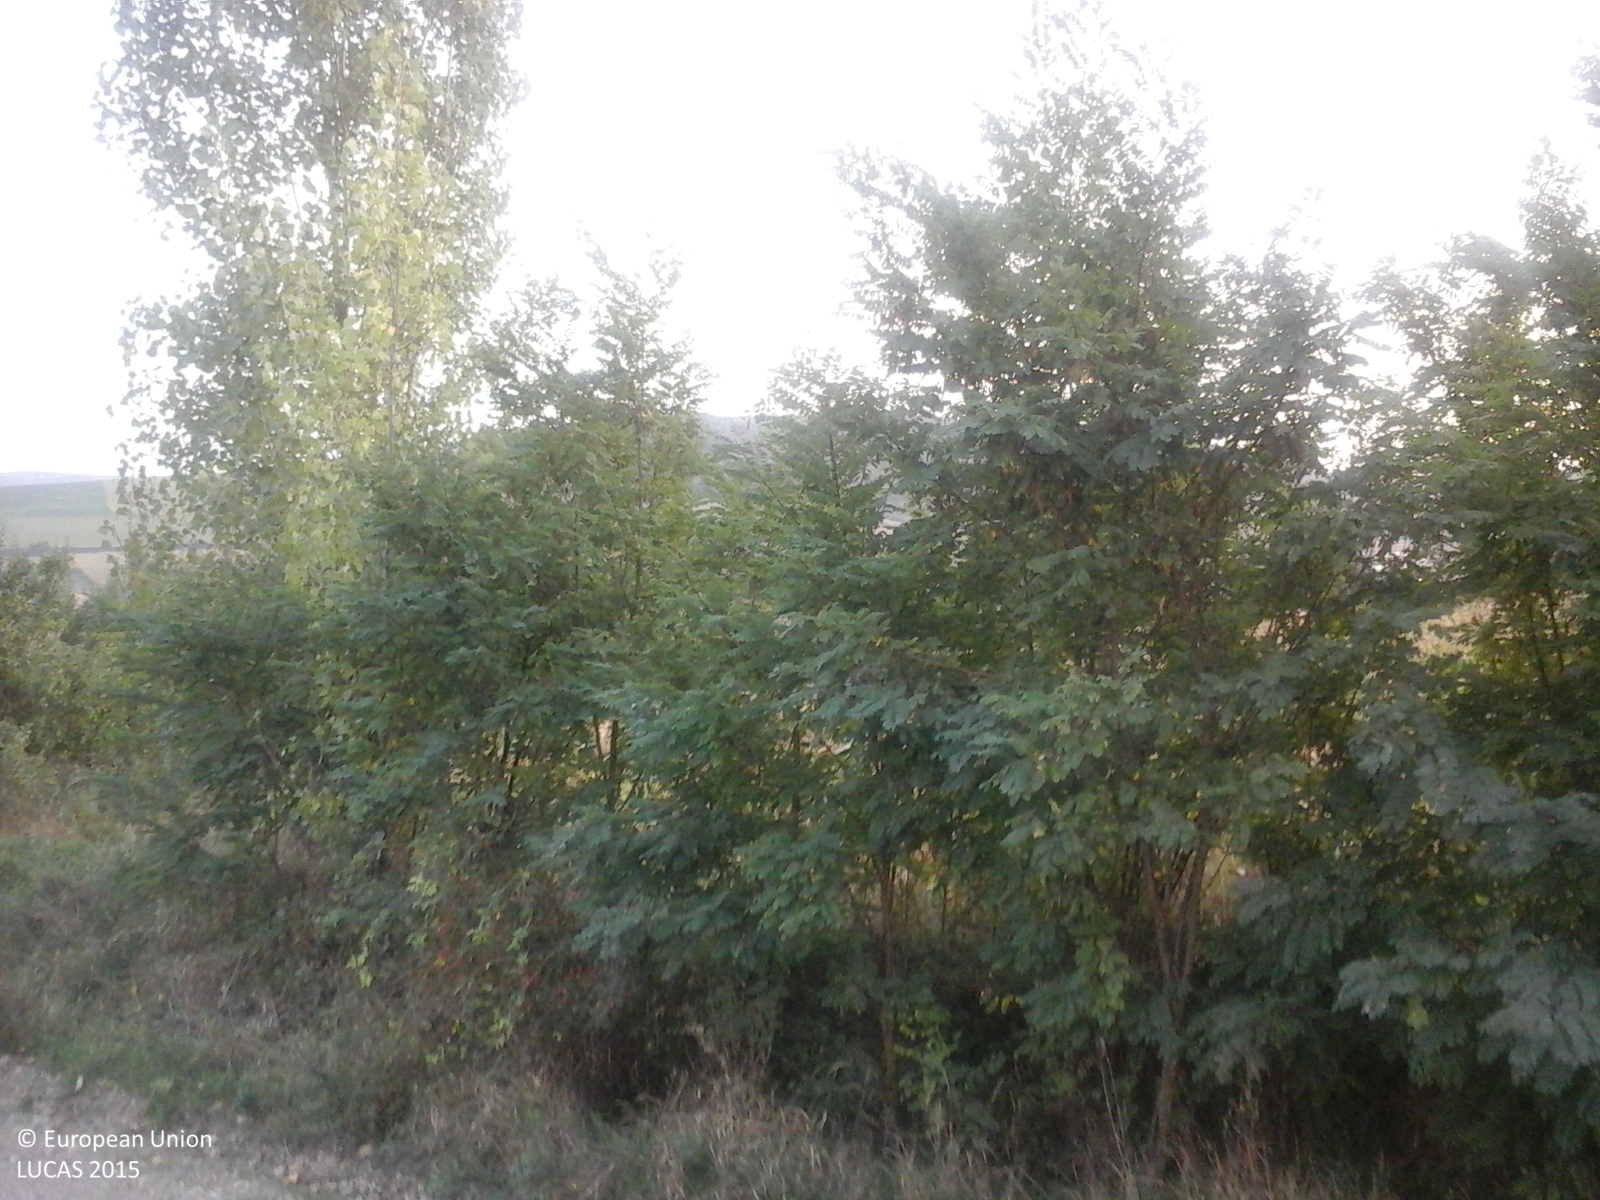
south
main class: Cropland
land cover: Maize
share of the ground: > 75 %
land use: Agriculture (excluding fallow land and kitchen gardens)
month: September
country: RO
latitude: 46.7346
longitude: 24.0426
